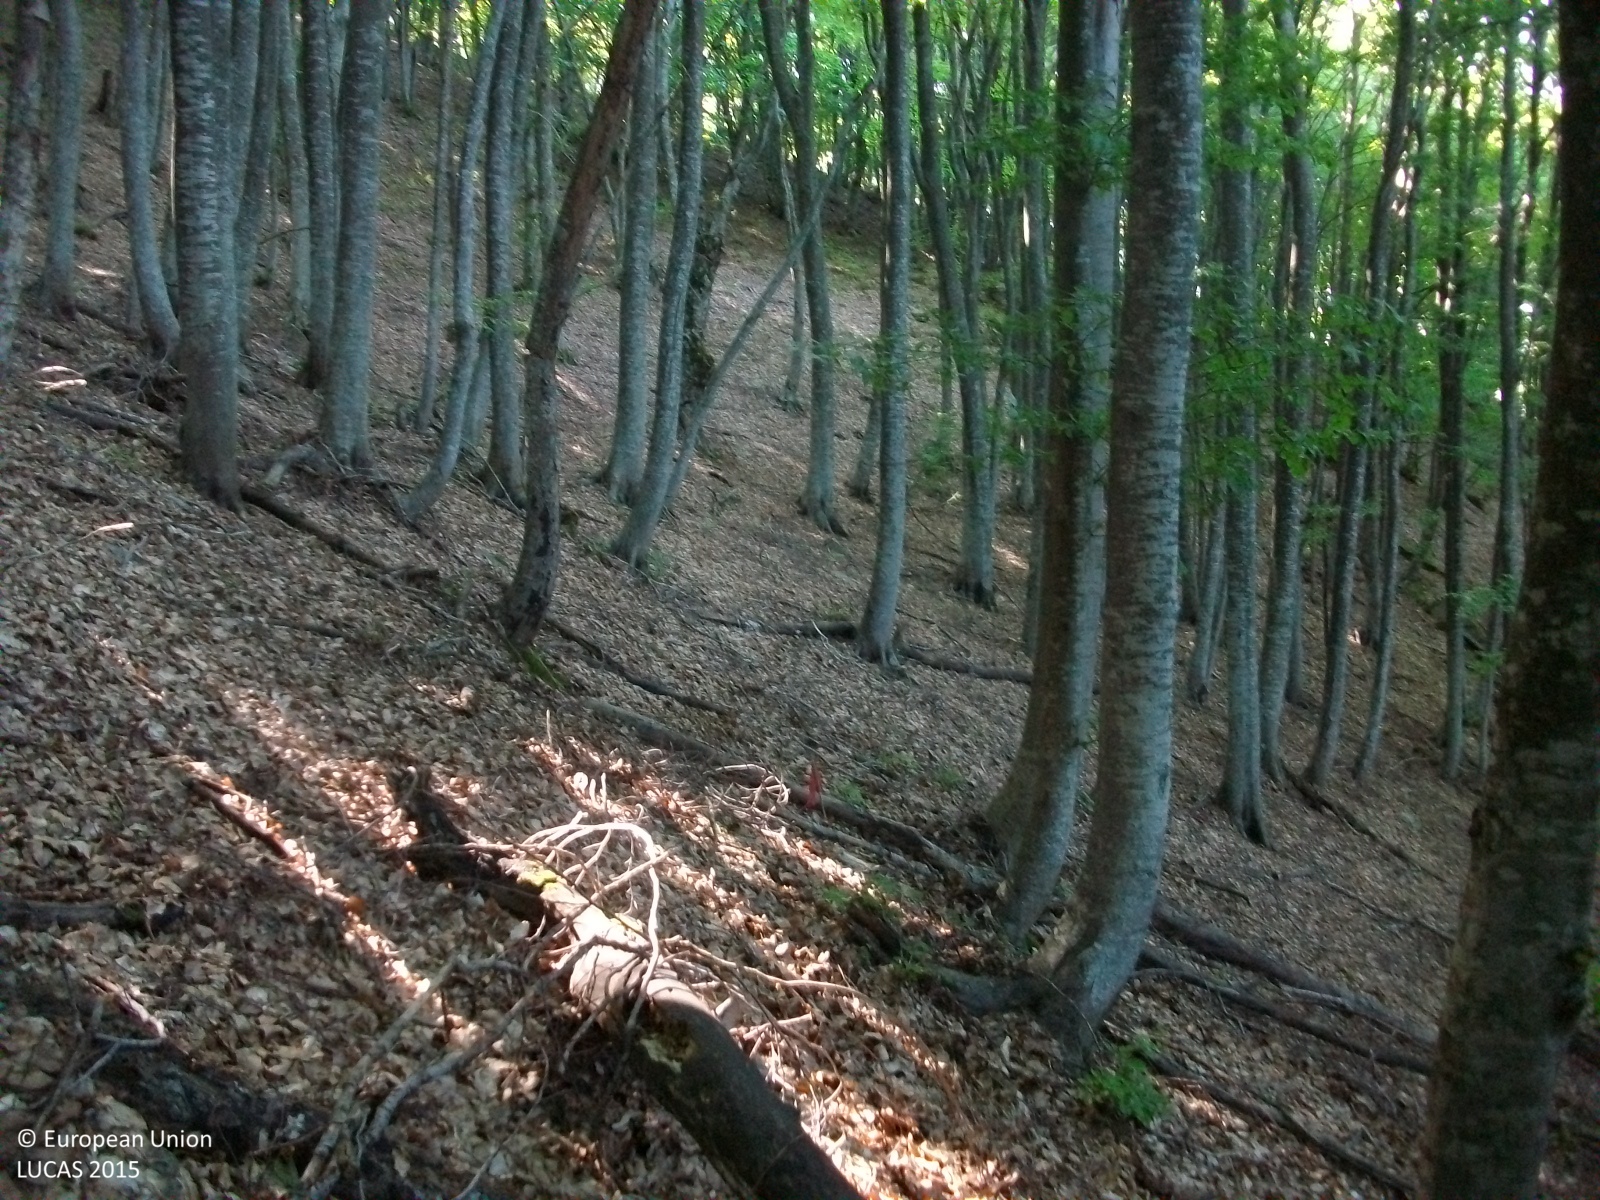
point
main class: Woodland
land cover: Broadleaved woodland
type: beech forest
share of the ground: > 75 %
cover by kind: broadleaved forest trees 100 %
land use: Forestry
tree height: > 5 m
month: June
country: GR
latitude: 39.5102
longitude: 22.9852
